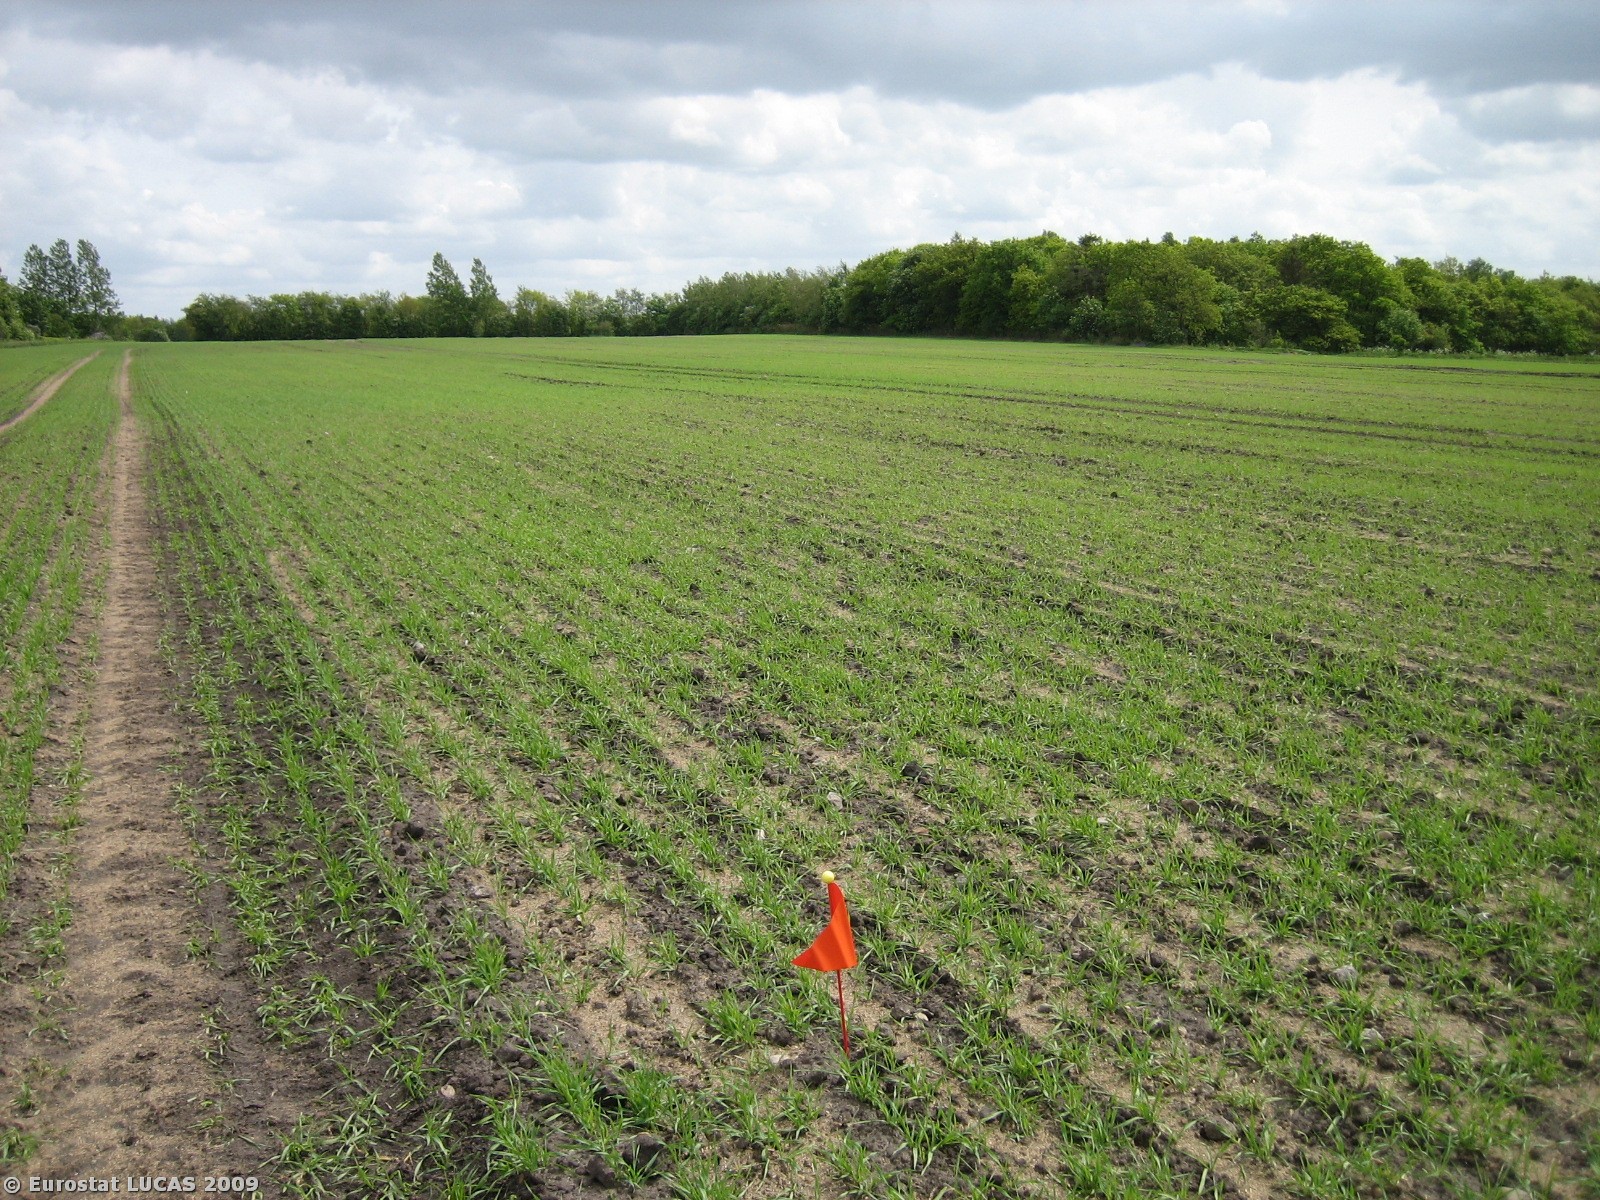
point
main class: Cropland
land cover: Barley
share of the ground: 50 - 75 %
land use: Agriculture (excluding fallow land and kitchen gardens)
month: May
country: DK
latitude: 56.1829
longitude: 8.8896
